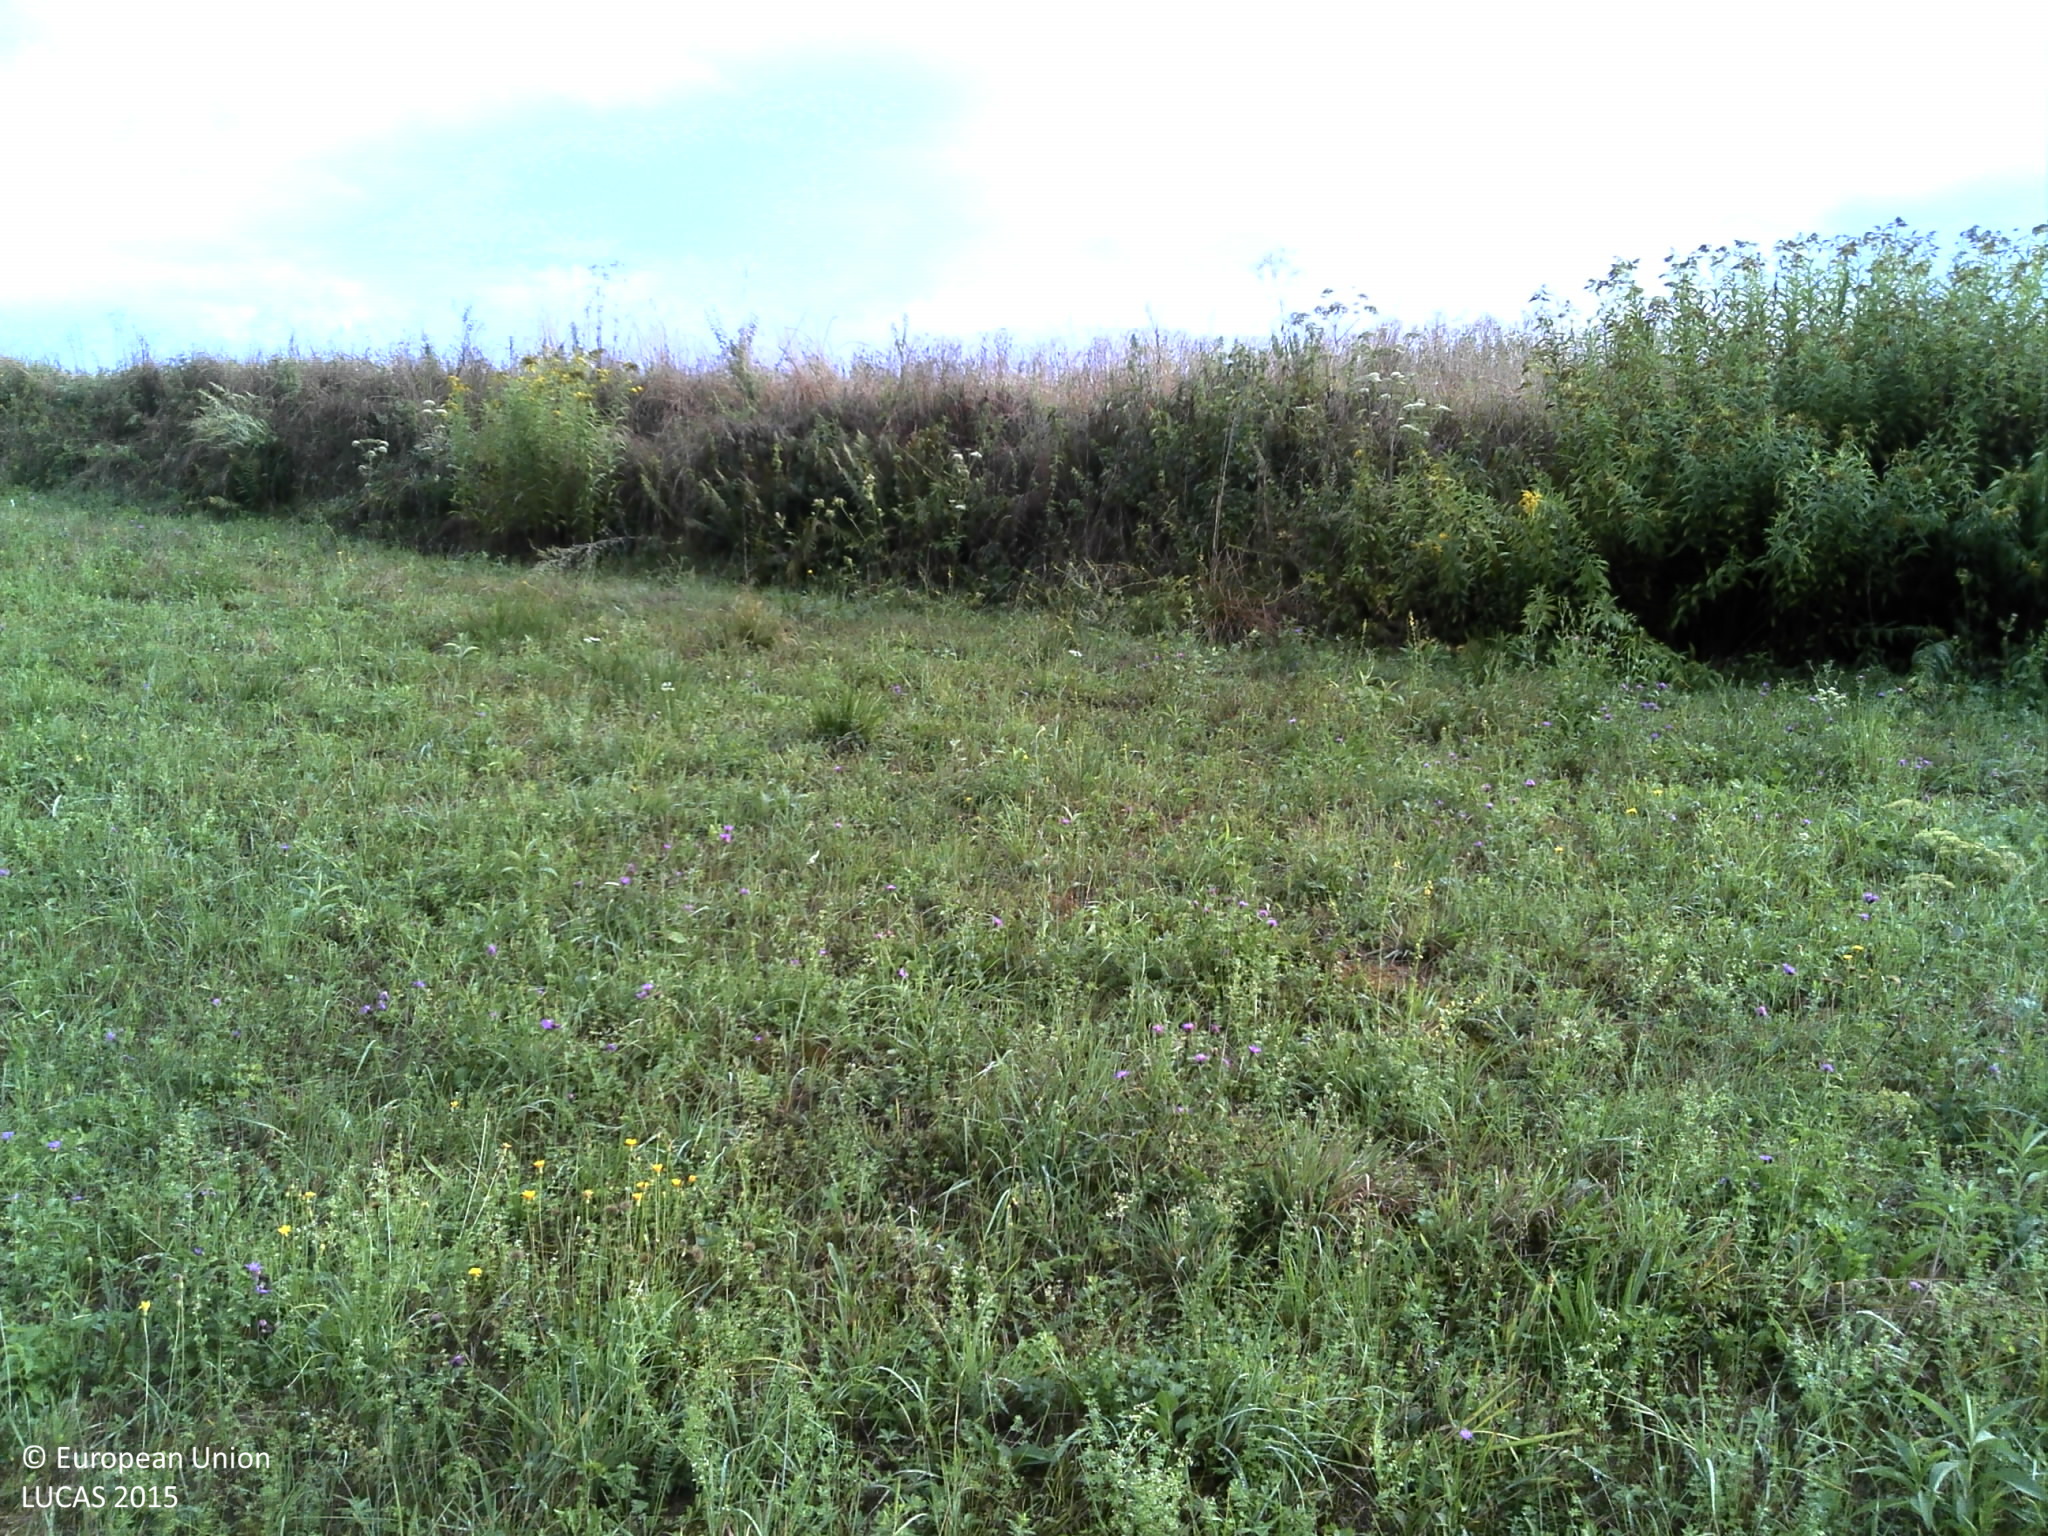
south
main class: Grassland
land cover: Spontaneously vegetated surfaces
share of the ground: > 75 %
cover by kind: herbaceous plants 100 %
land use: Agriculture (excluding fallow land and kitchen gardens)
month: August
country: HR
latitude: 45.4388
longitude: 15.7363
